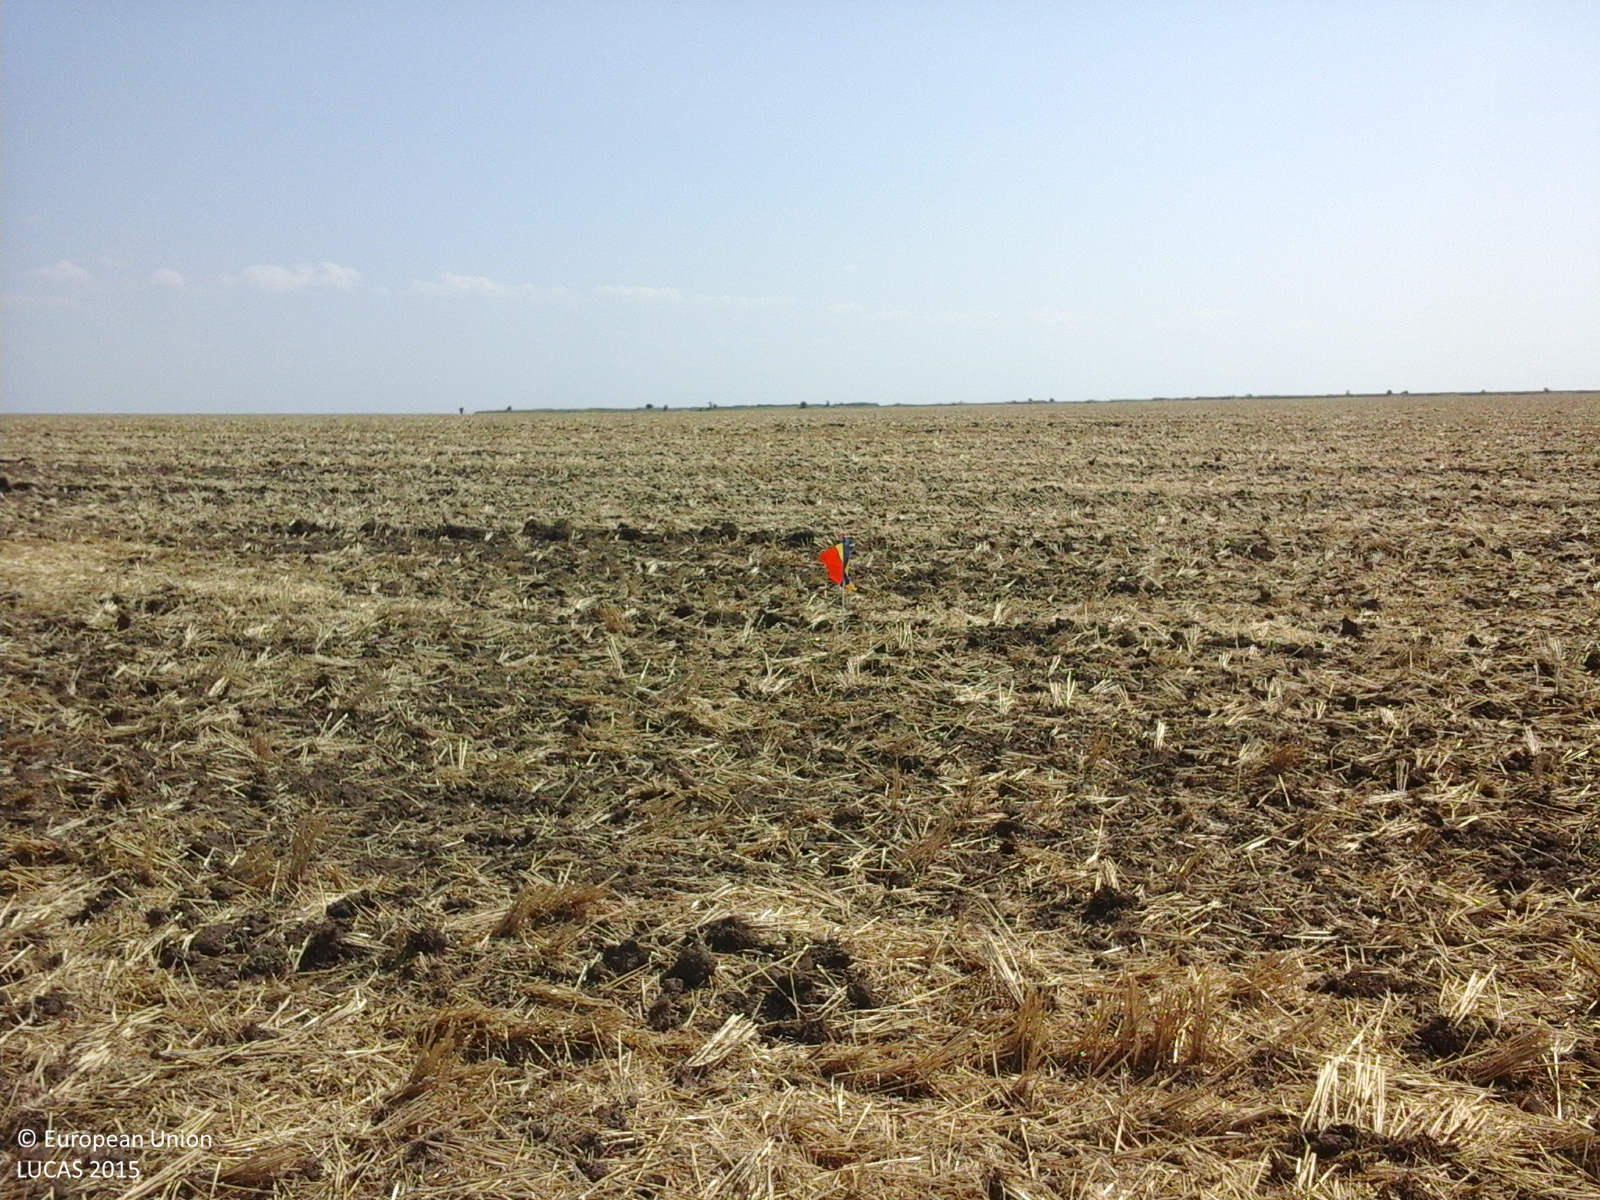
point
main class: Cropland
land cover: Durum wheat
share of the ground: < 10 %
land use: Agriculture (excluding fallow land and kitchen gardens)
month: July
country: RO
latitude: 44.5048
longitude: 27.5136
